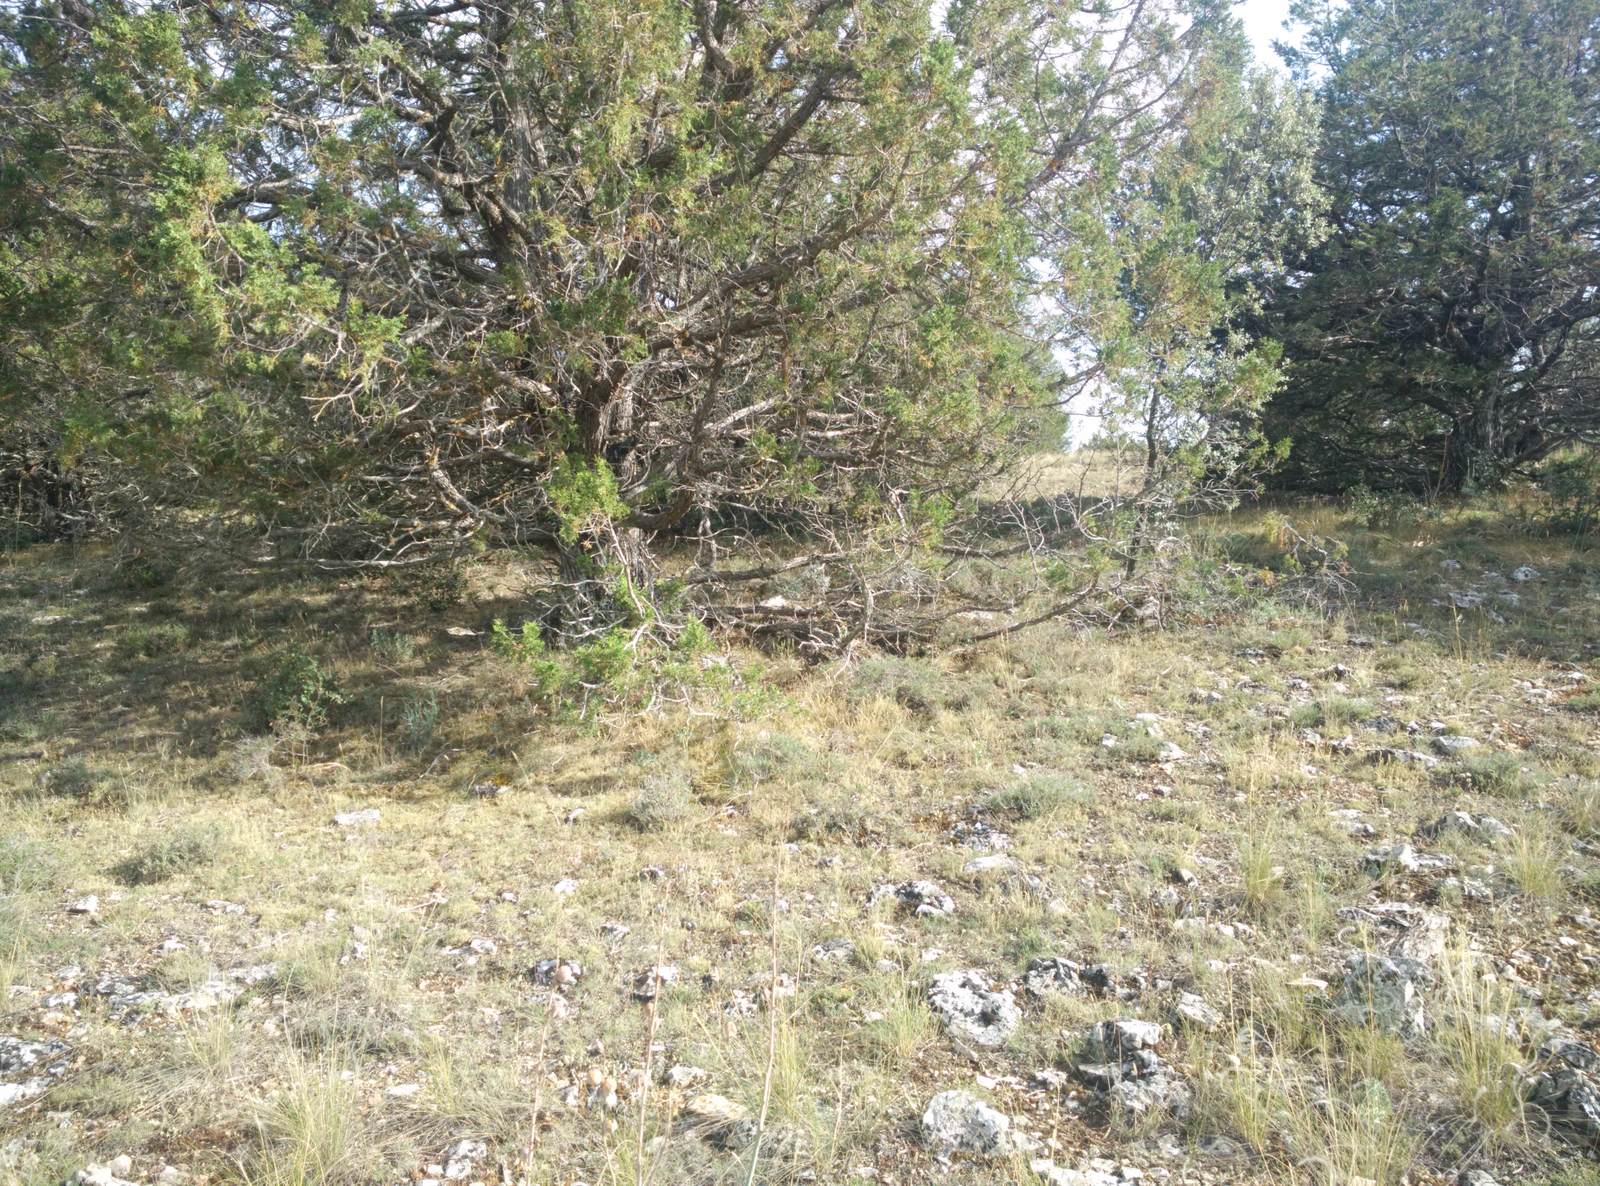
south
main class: Woodland
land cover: Other coniferous woodland
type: coniferous forest of the mediterranean region
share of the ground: 25 - 50 %
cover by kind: unconsolidated bare surface 45 %, coniferous forest trees 35 %, shrubs 10 %, broadleaved forest trees 5 %, herbaceous plants 5 %
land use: Semi-natural and natural areas not in use
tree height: > 5 m
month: July
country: ES
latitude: 41.0553
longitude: -2.0554
